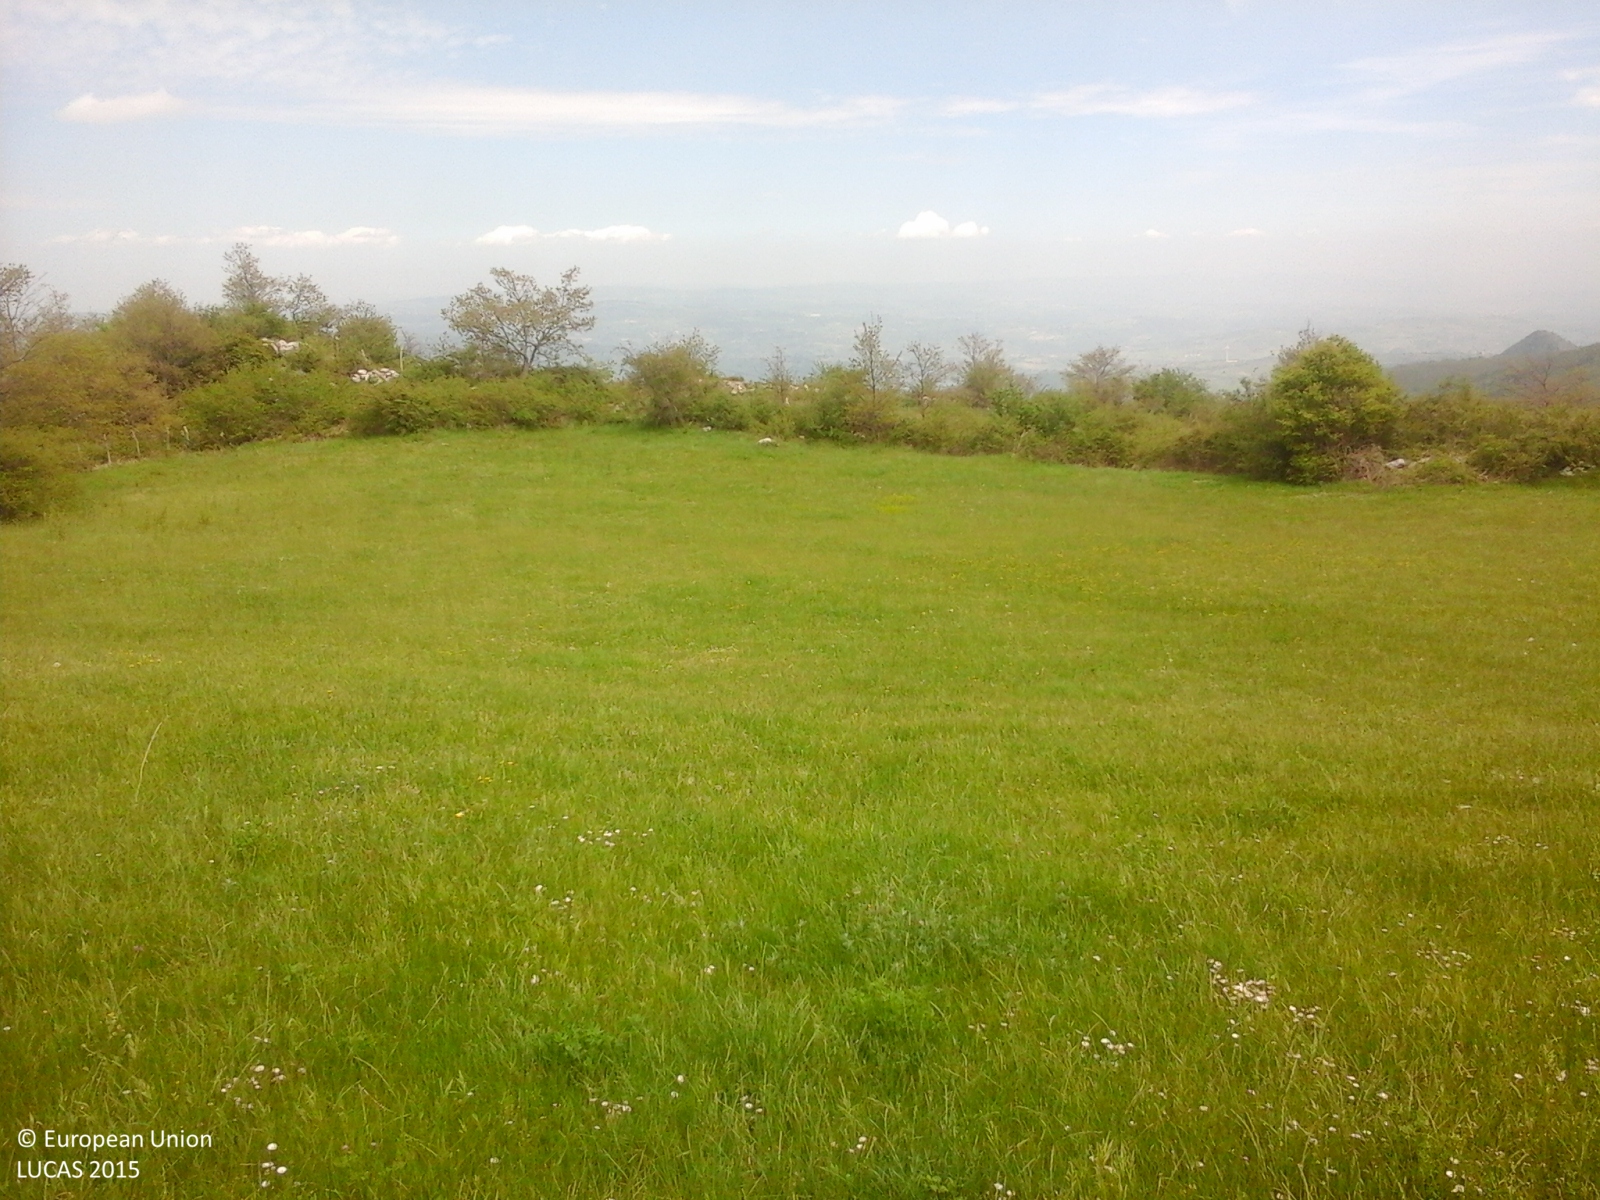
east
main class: Grassland
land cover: Grassland without tree/shrub cover
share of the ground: > 75 %
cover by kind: herbaceous plants 100 %
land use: Agriculture (excluding fallow land and kitchen gardens)
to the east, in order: Grassland without tree/shrub cover; Abandoned hedges; Fences; Rock outcrops; Grassland with sparse tree/shrub cover; Rock outcrops; Grassland with sparse tree/shrub cover; Rock outcrops; Broadleaved woodland
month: May
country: IT
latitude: 41.3356
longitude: 14.6313
